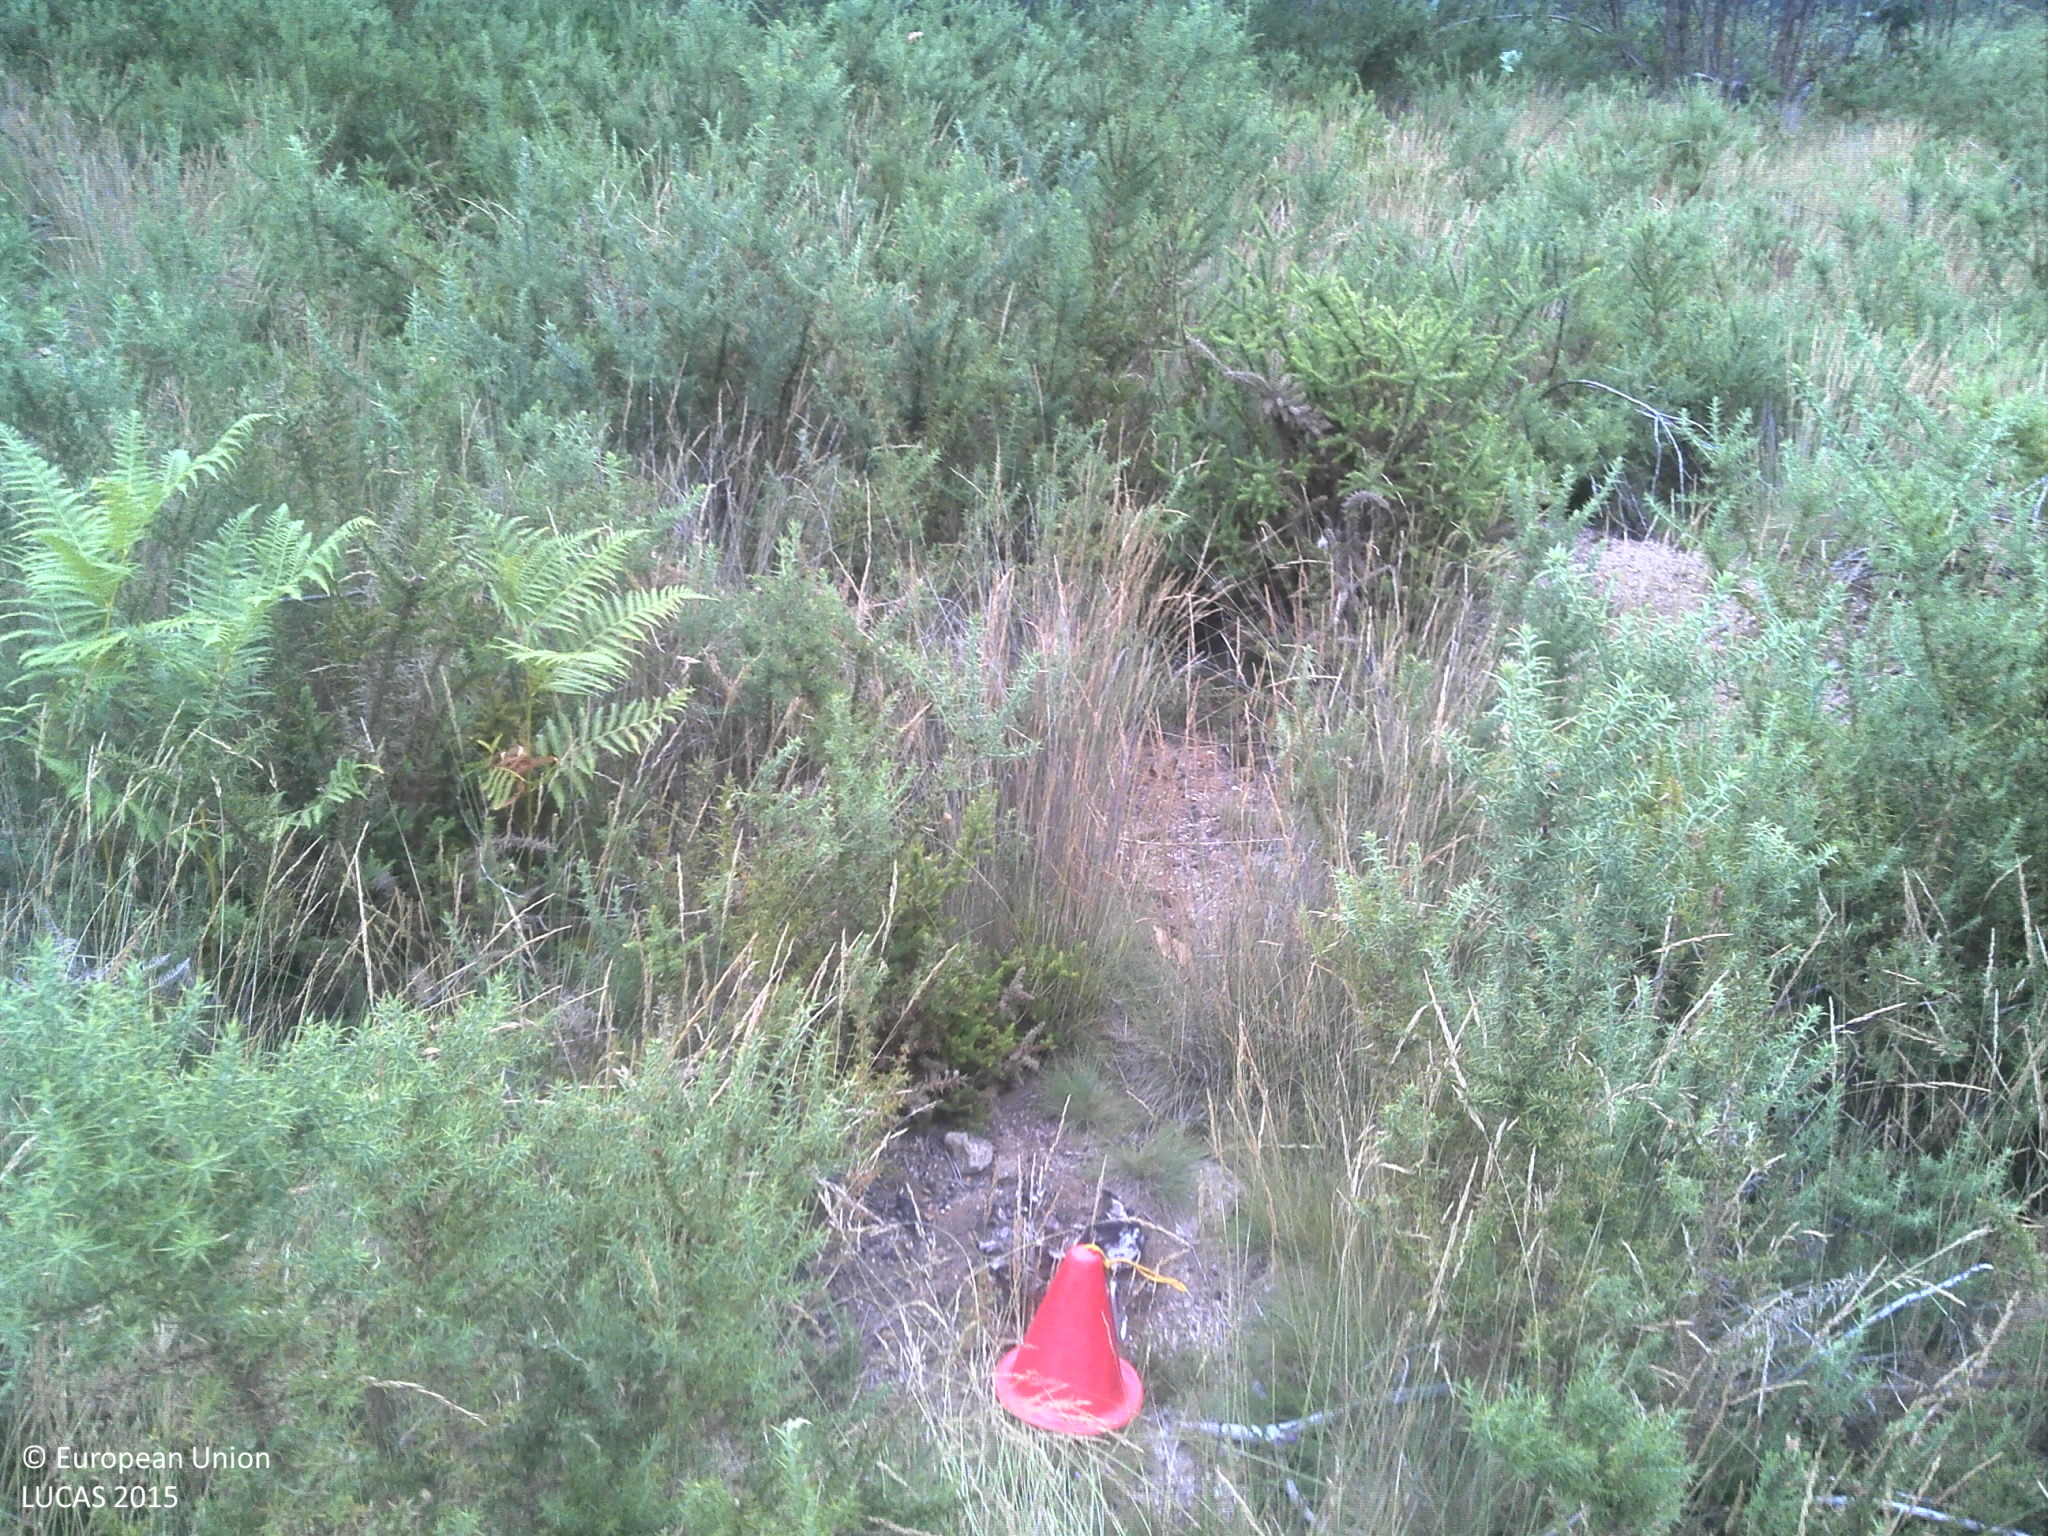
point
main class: Shrubland
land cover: Shrubland with sparse tree cover
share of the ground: 50 - 75 %
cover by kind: shrubs 75 %, herbaceous plants 15 %, broadleaved forest trees 5 %, unconsolidated bare surface 5 %
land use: Forestry
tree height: > 5 m
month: June
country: PT
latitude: 41.2521
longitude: -8.2723
